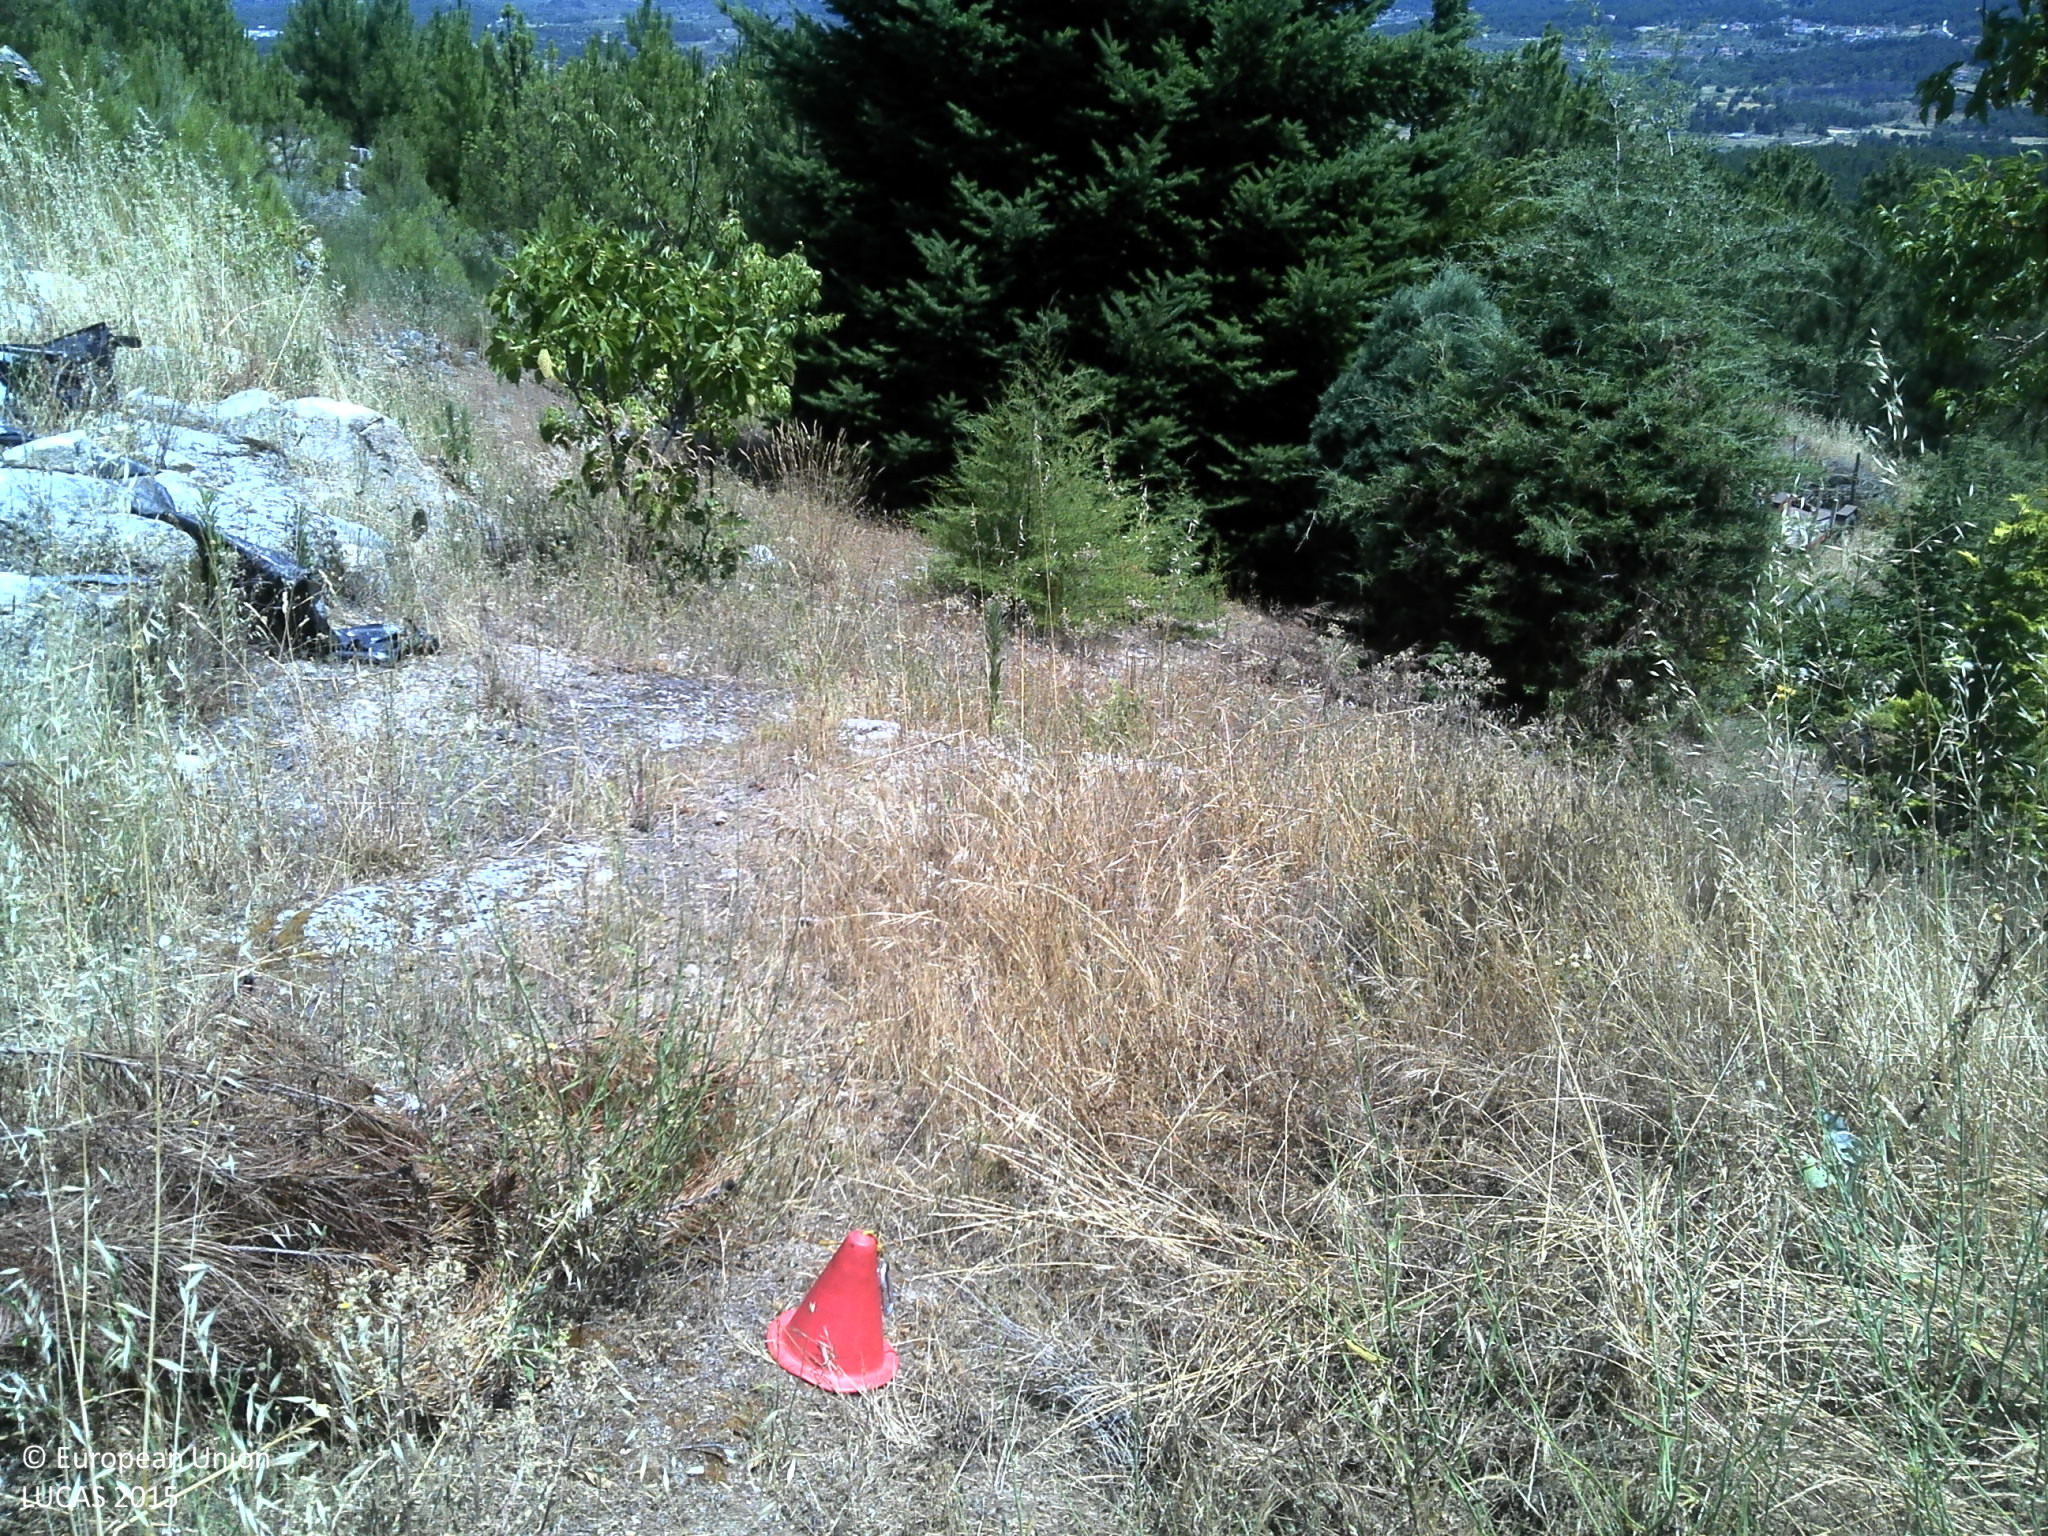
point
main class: Grassland
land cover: Grassland with sparse tree/shrub cover
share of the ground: 50 - 75 %
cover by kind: herbaceous plants 40 %, consolidated bare surface 20 %, unconsolidated bare surface 15 %, shrubs 10 %, coniferous forest trees 5 %
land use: Abandoned areas
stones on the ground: 25 - 50 %
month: July
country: PT
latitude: 41.5552
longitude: -7.6243
